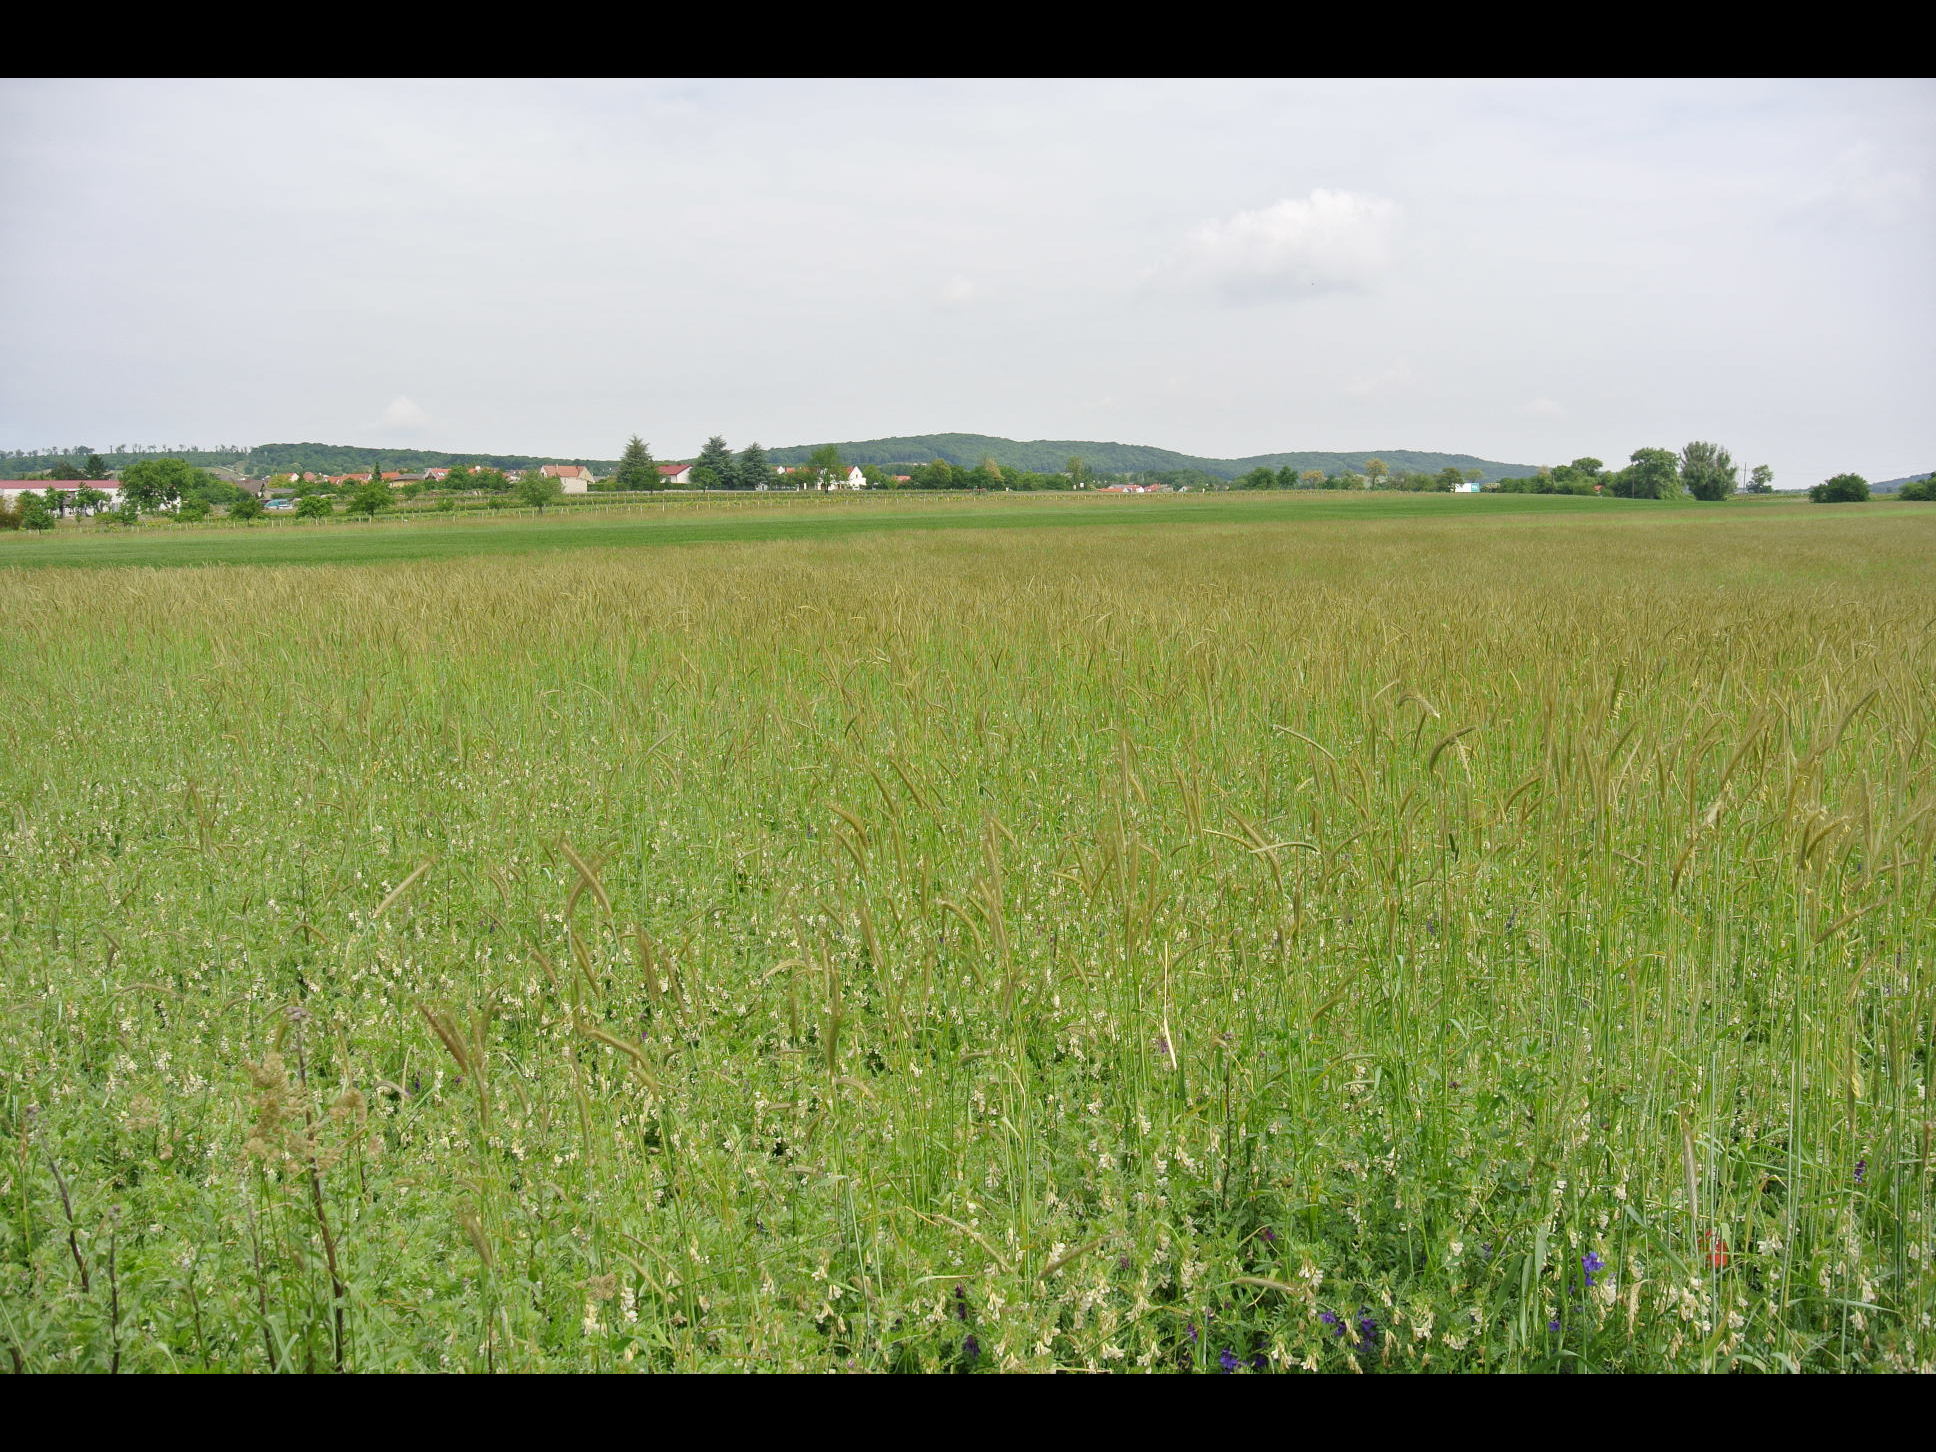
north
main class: Cropland
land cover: Other leguminous and mixtures for fodder
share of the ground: > 75 %
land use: Agriculture (excluding fallow land and kitchen gardens)
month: May
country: AT
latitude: 47.9450
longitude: 16.7402
